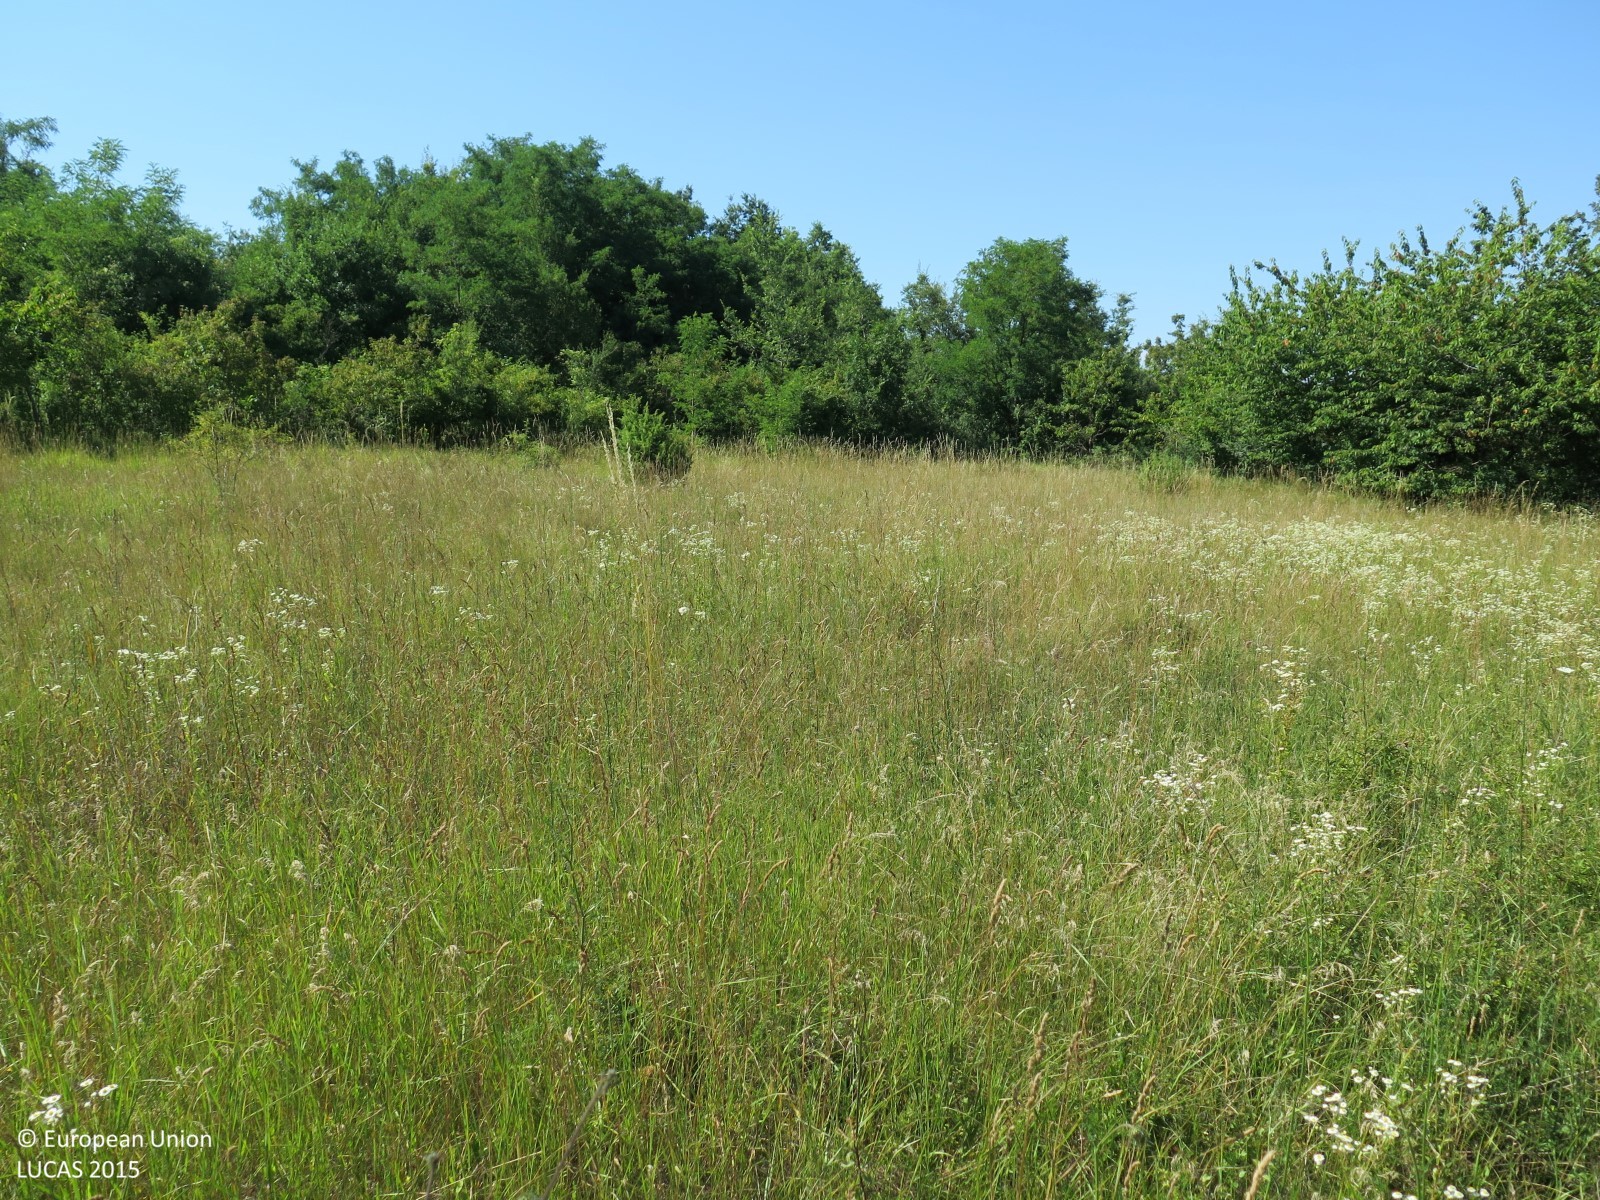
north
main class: Shrubland
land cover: Shrubland without tree cover
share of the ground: > 75 %
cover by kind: shrubs 95 %, herbaceous plants 5 %
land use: Semi-natural and natural areas not in use
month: July
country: HR
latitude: 45.1987
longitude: 13.8773
